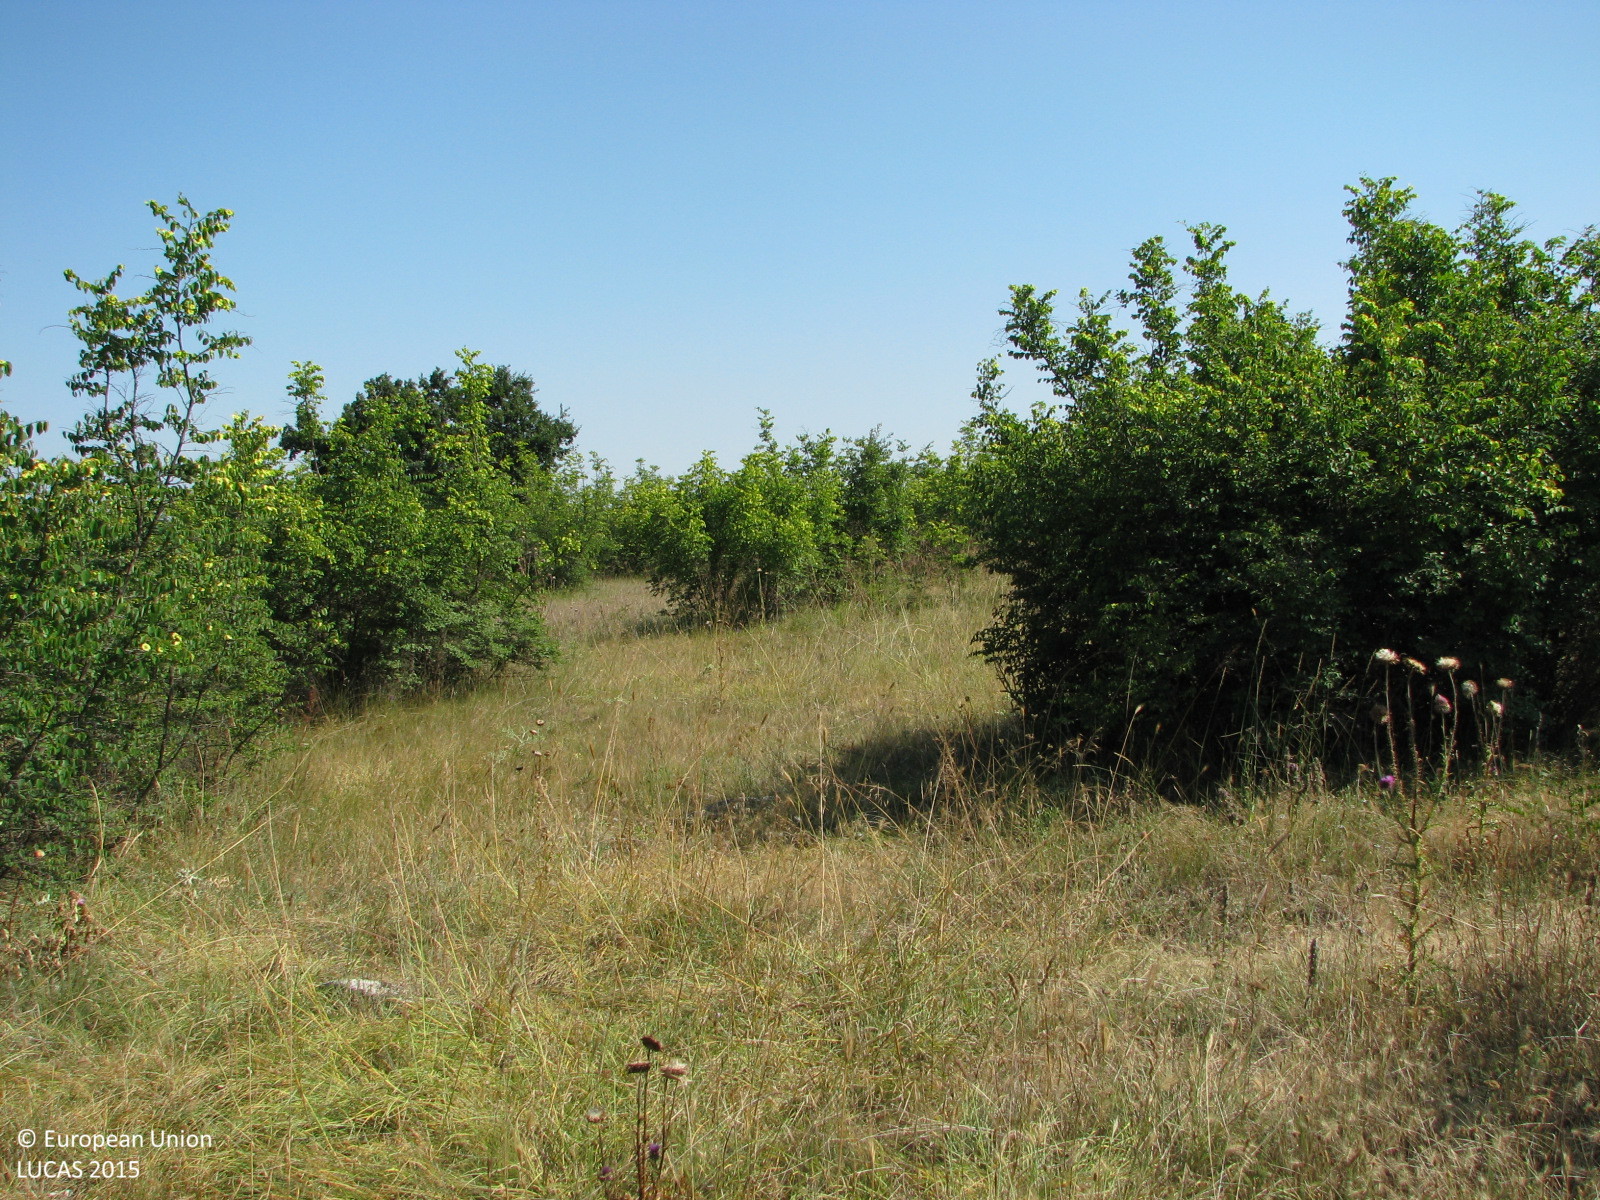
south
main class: Shrubland
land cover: Shrubland without tree cover
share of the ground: > 75 %
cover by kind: herbaceous plants 80 %, shrubs 20 %
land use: Semi-natural and natural areas not in use
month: July
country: BG
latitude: 42.2766
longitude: 26.8678
